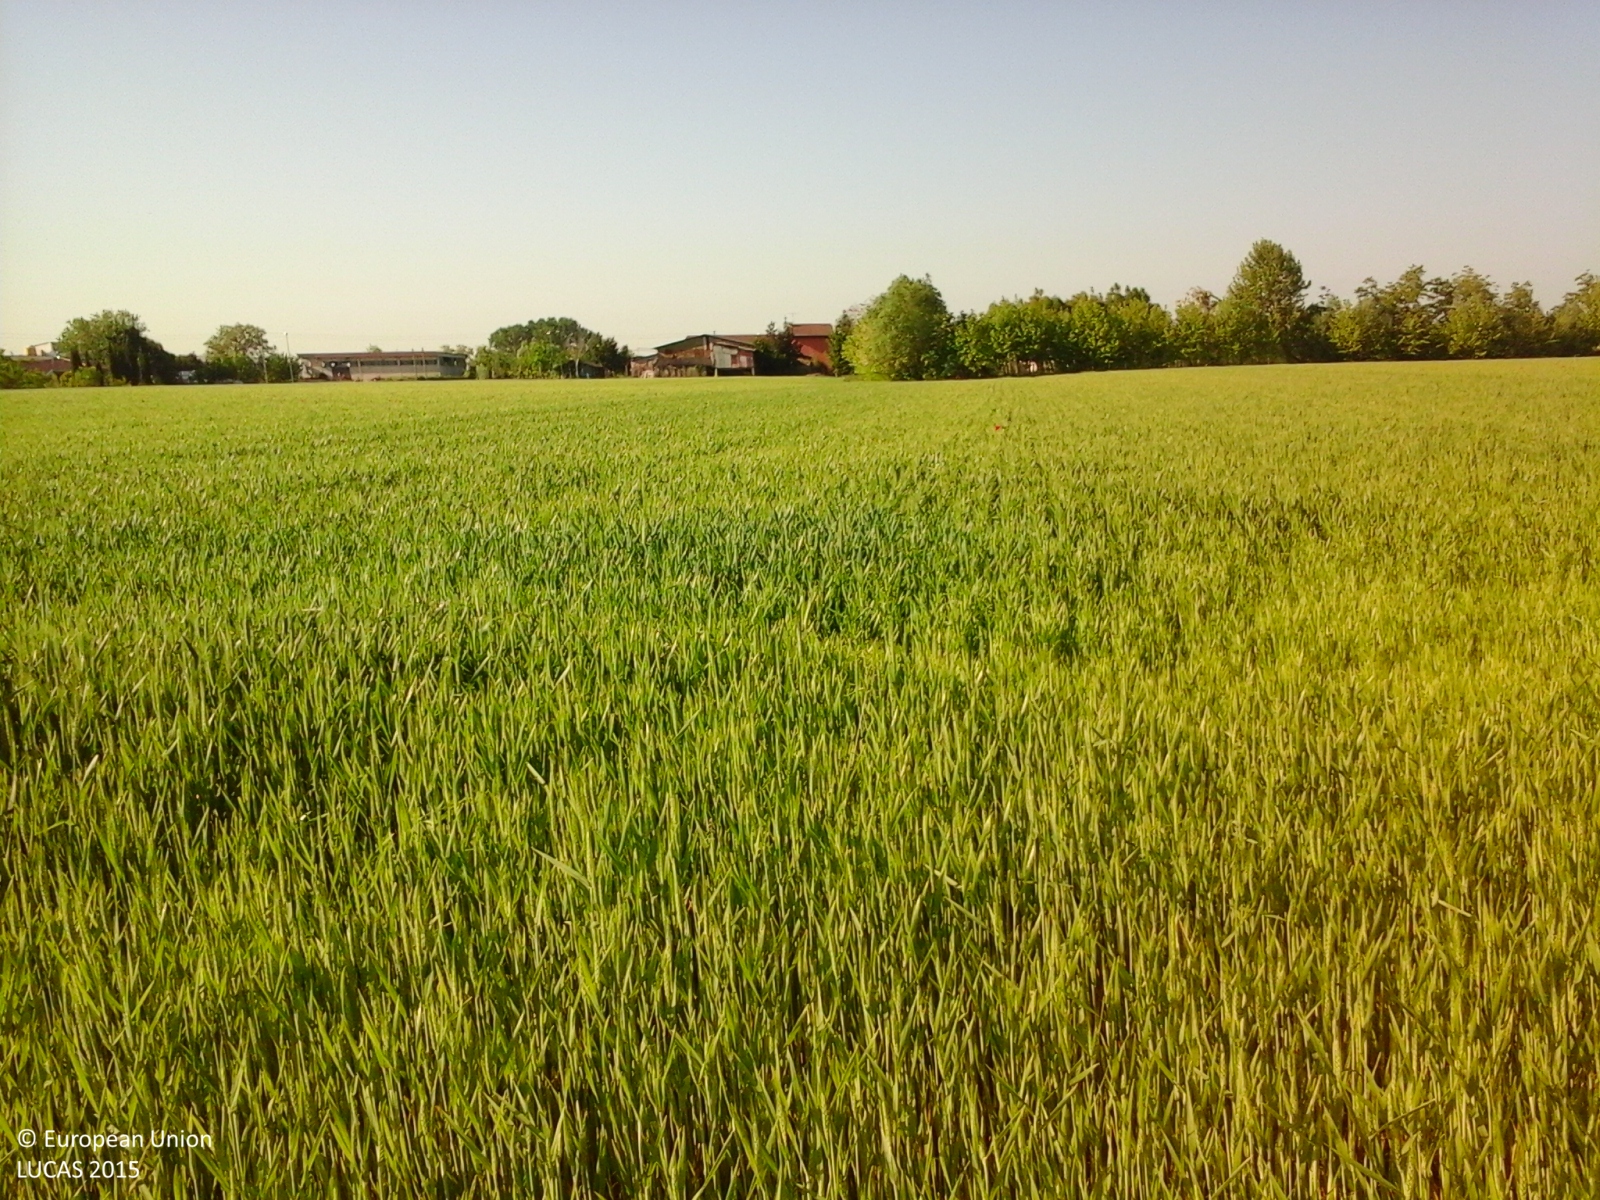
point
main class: Cropland
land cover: Common wheat
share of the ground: > 75 %
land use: Agriculture (excluding fallow land and kitchen gardens)
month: May
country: IT
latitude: 45.3246
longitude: 11.9232
